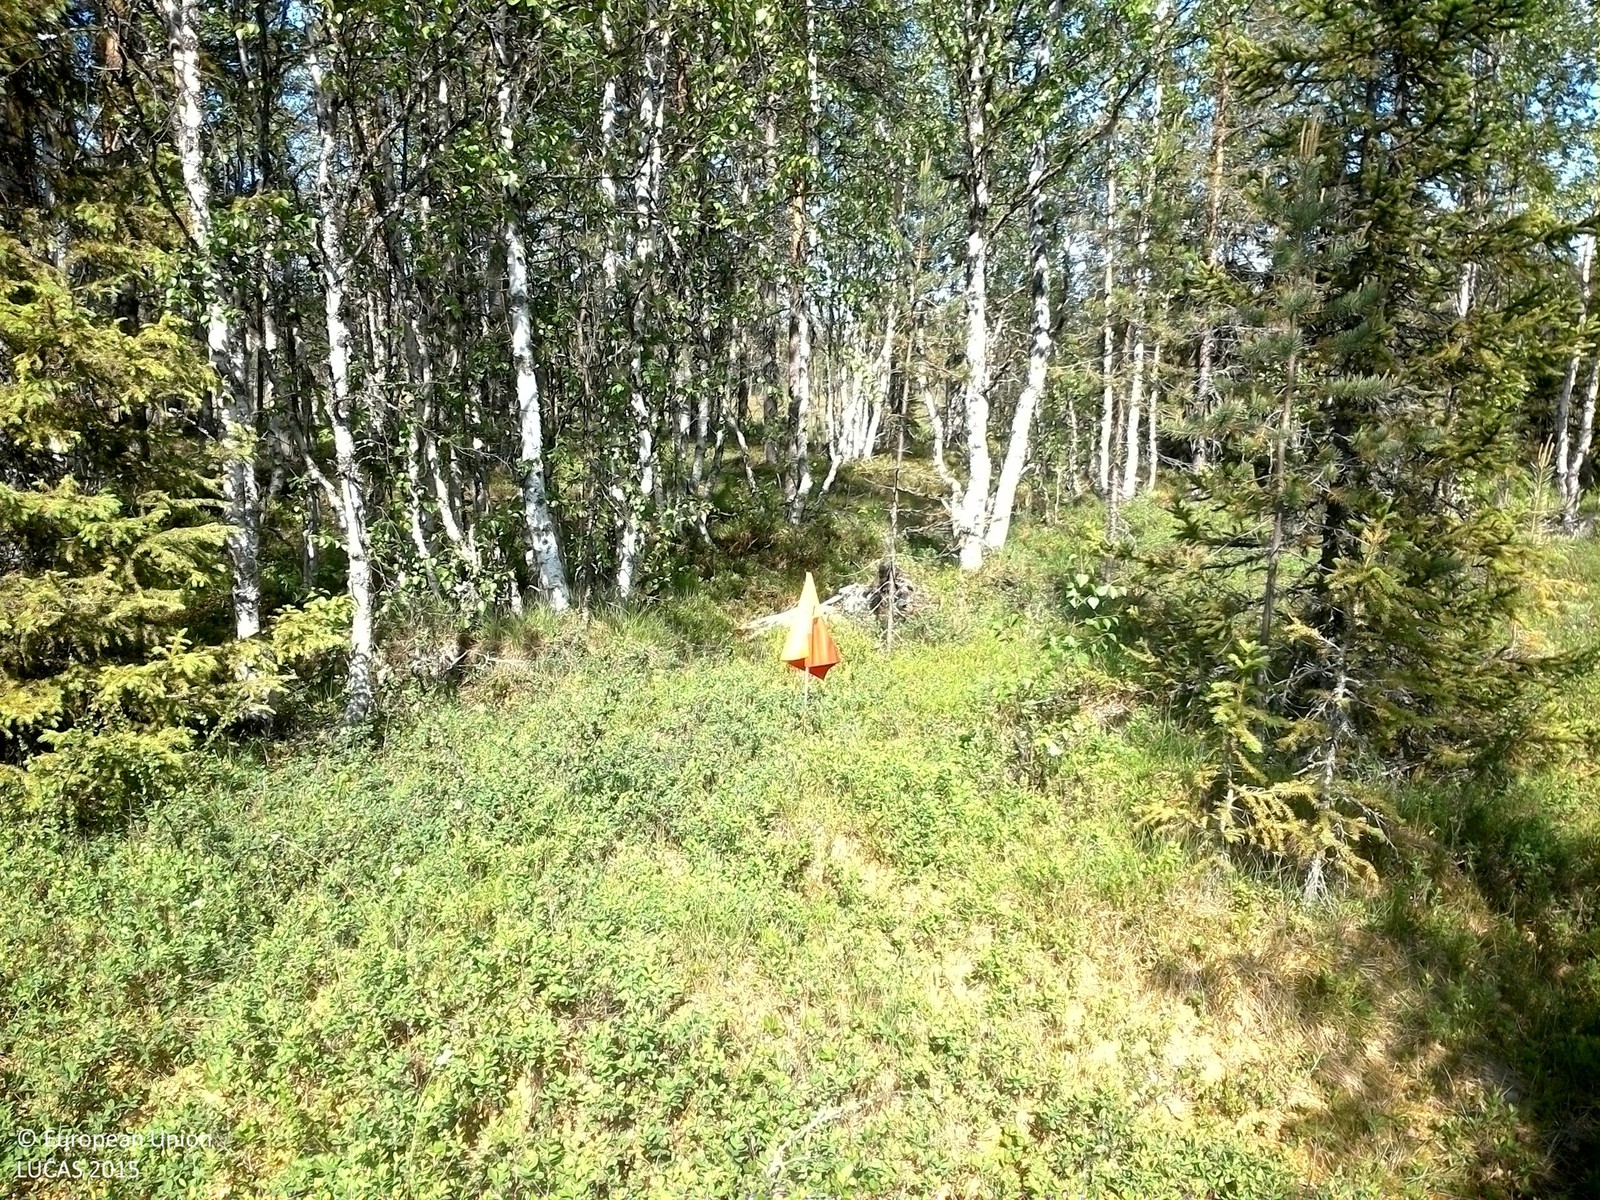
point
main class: Woodland
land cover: Pine dominated mixed woodland
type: boreal forest
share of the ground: 25 - 50 %
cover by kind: coniferous forest trees 35 %, shrubs 30 %, broadleaved forest trees 15 %, lichens and mosses 15 %, herbaceous plants 5 %
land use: Forestry
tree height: > 5 m
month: July
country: SE
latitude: 64.3474
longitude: 16.6971
